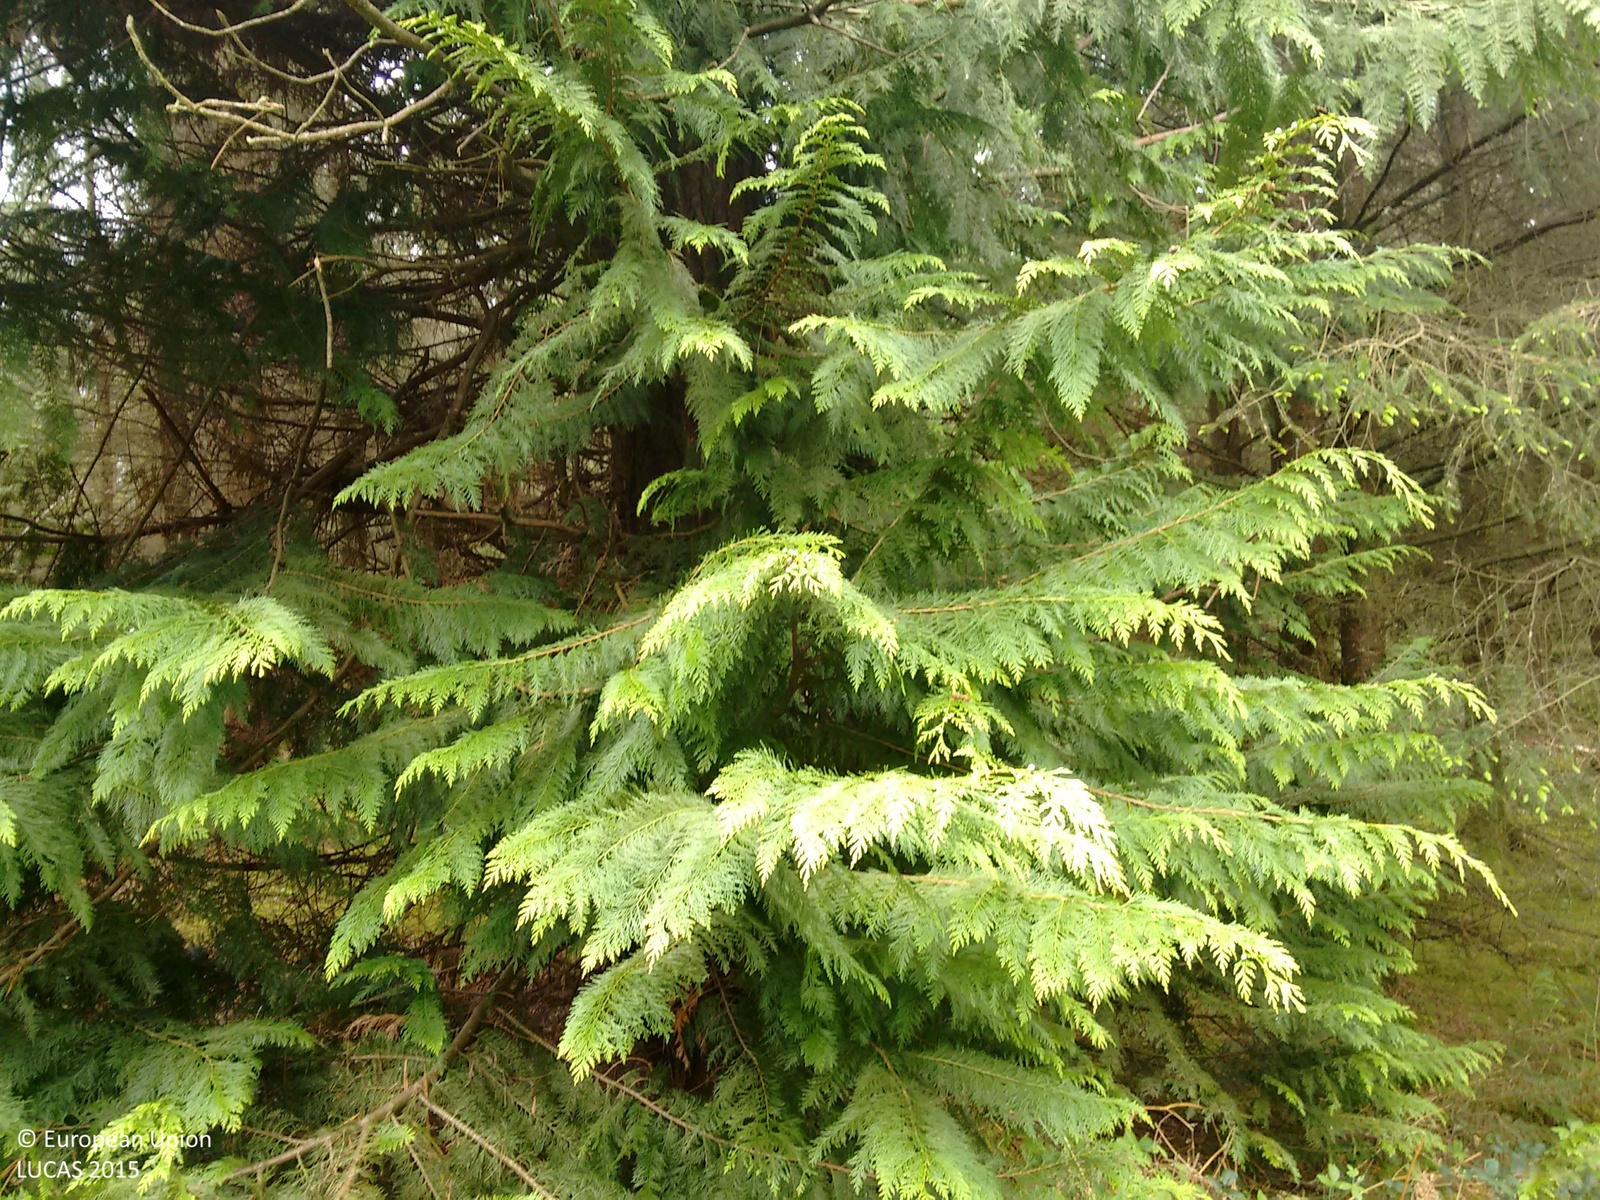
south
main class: Woodland
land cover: Spruce dominated coniferous woodland
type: boreal forest
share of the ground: > 75 %
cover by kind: coniferous forest trees 75 %, shrubs 10 %, herbaceous plants 10 %, broadleaved forest trees 5 %
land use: Forestry
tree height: > 5 m
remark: Fire break
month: May
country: IE
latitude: 53.3458
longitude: -8.7227
